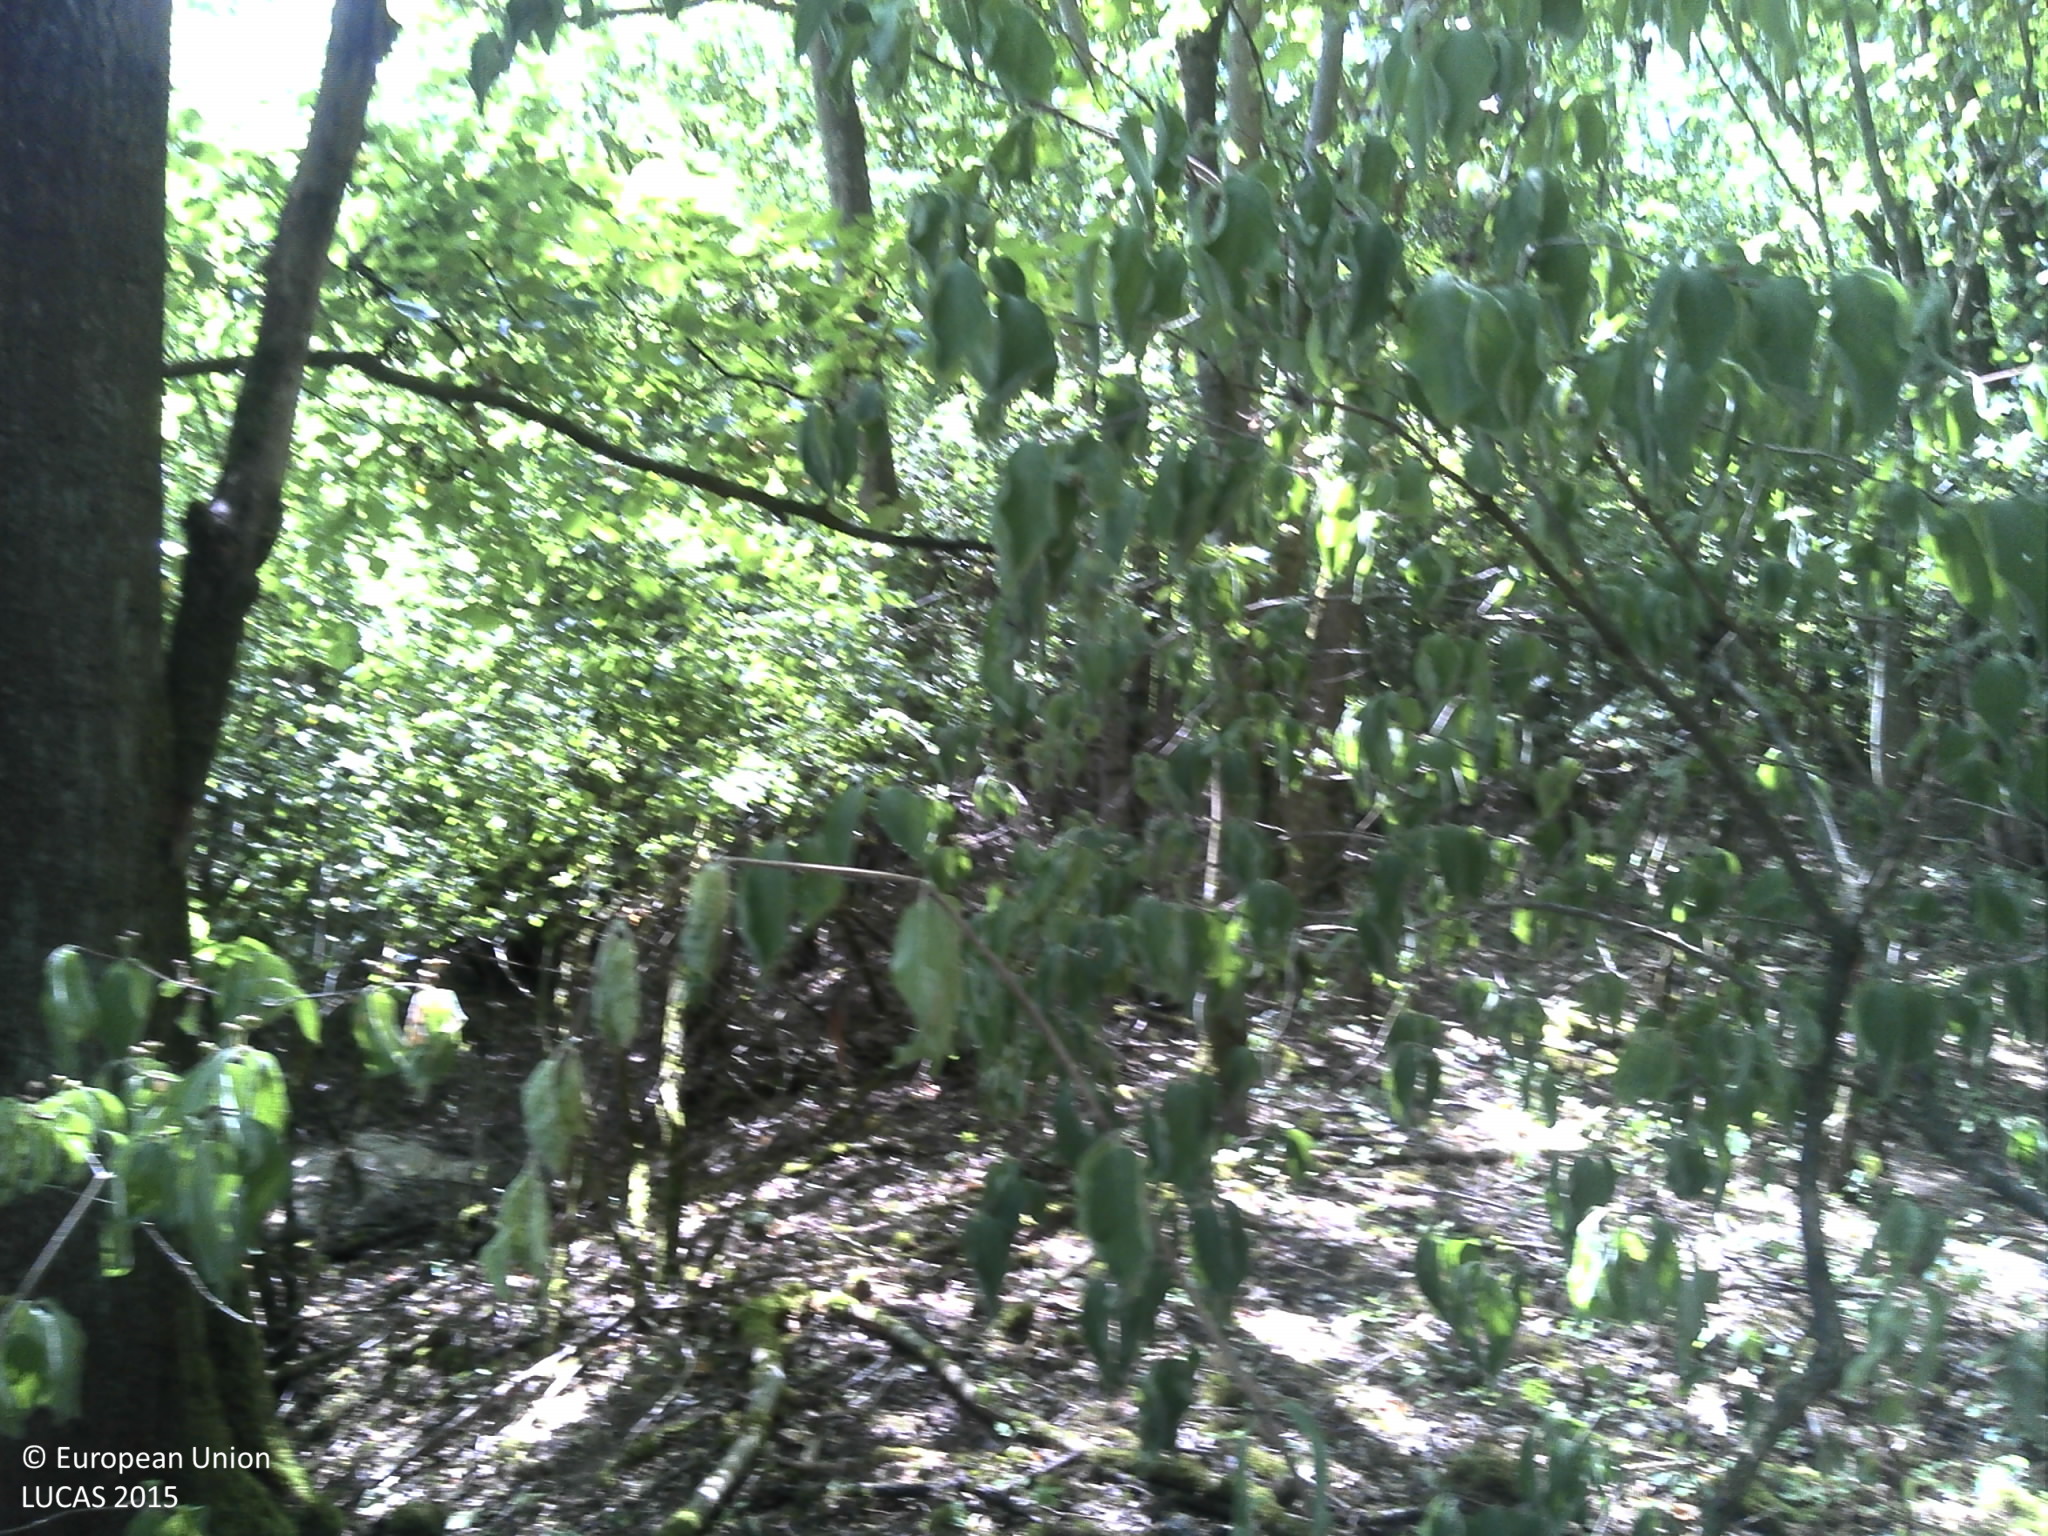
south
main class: Woodland
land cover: Broadleaved woodland
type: acidophilous oak and oak-birch forest
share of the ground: > 75 %
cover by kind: broadleaved forest trees 75 %, consolidated bare surface 15 %, herbaceous plants 10 %
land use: Forestry
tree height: > 5 m
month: July
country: FR
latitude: 49.4697
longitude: 4.0473
